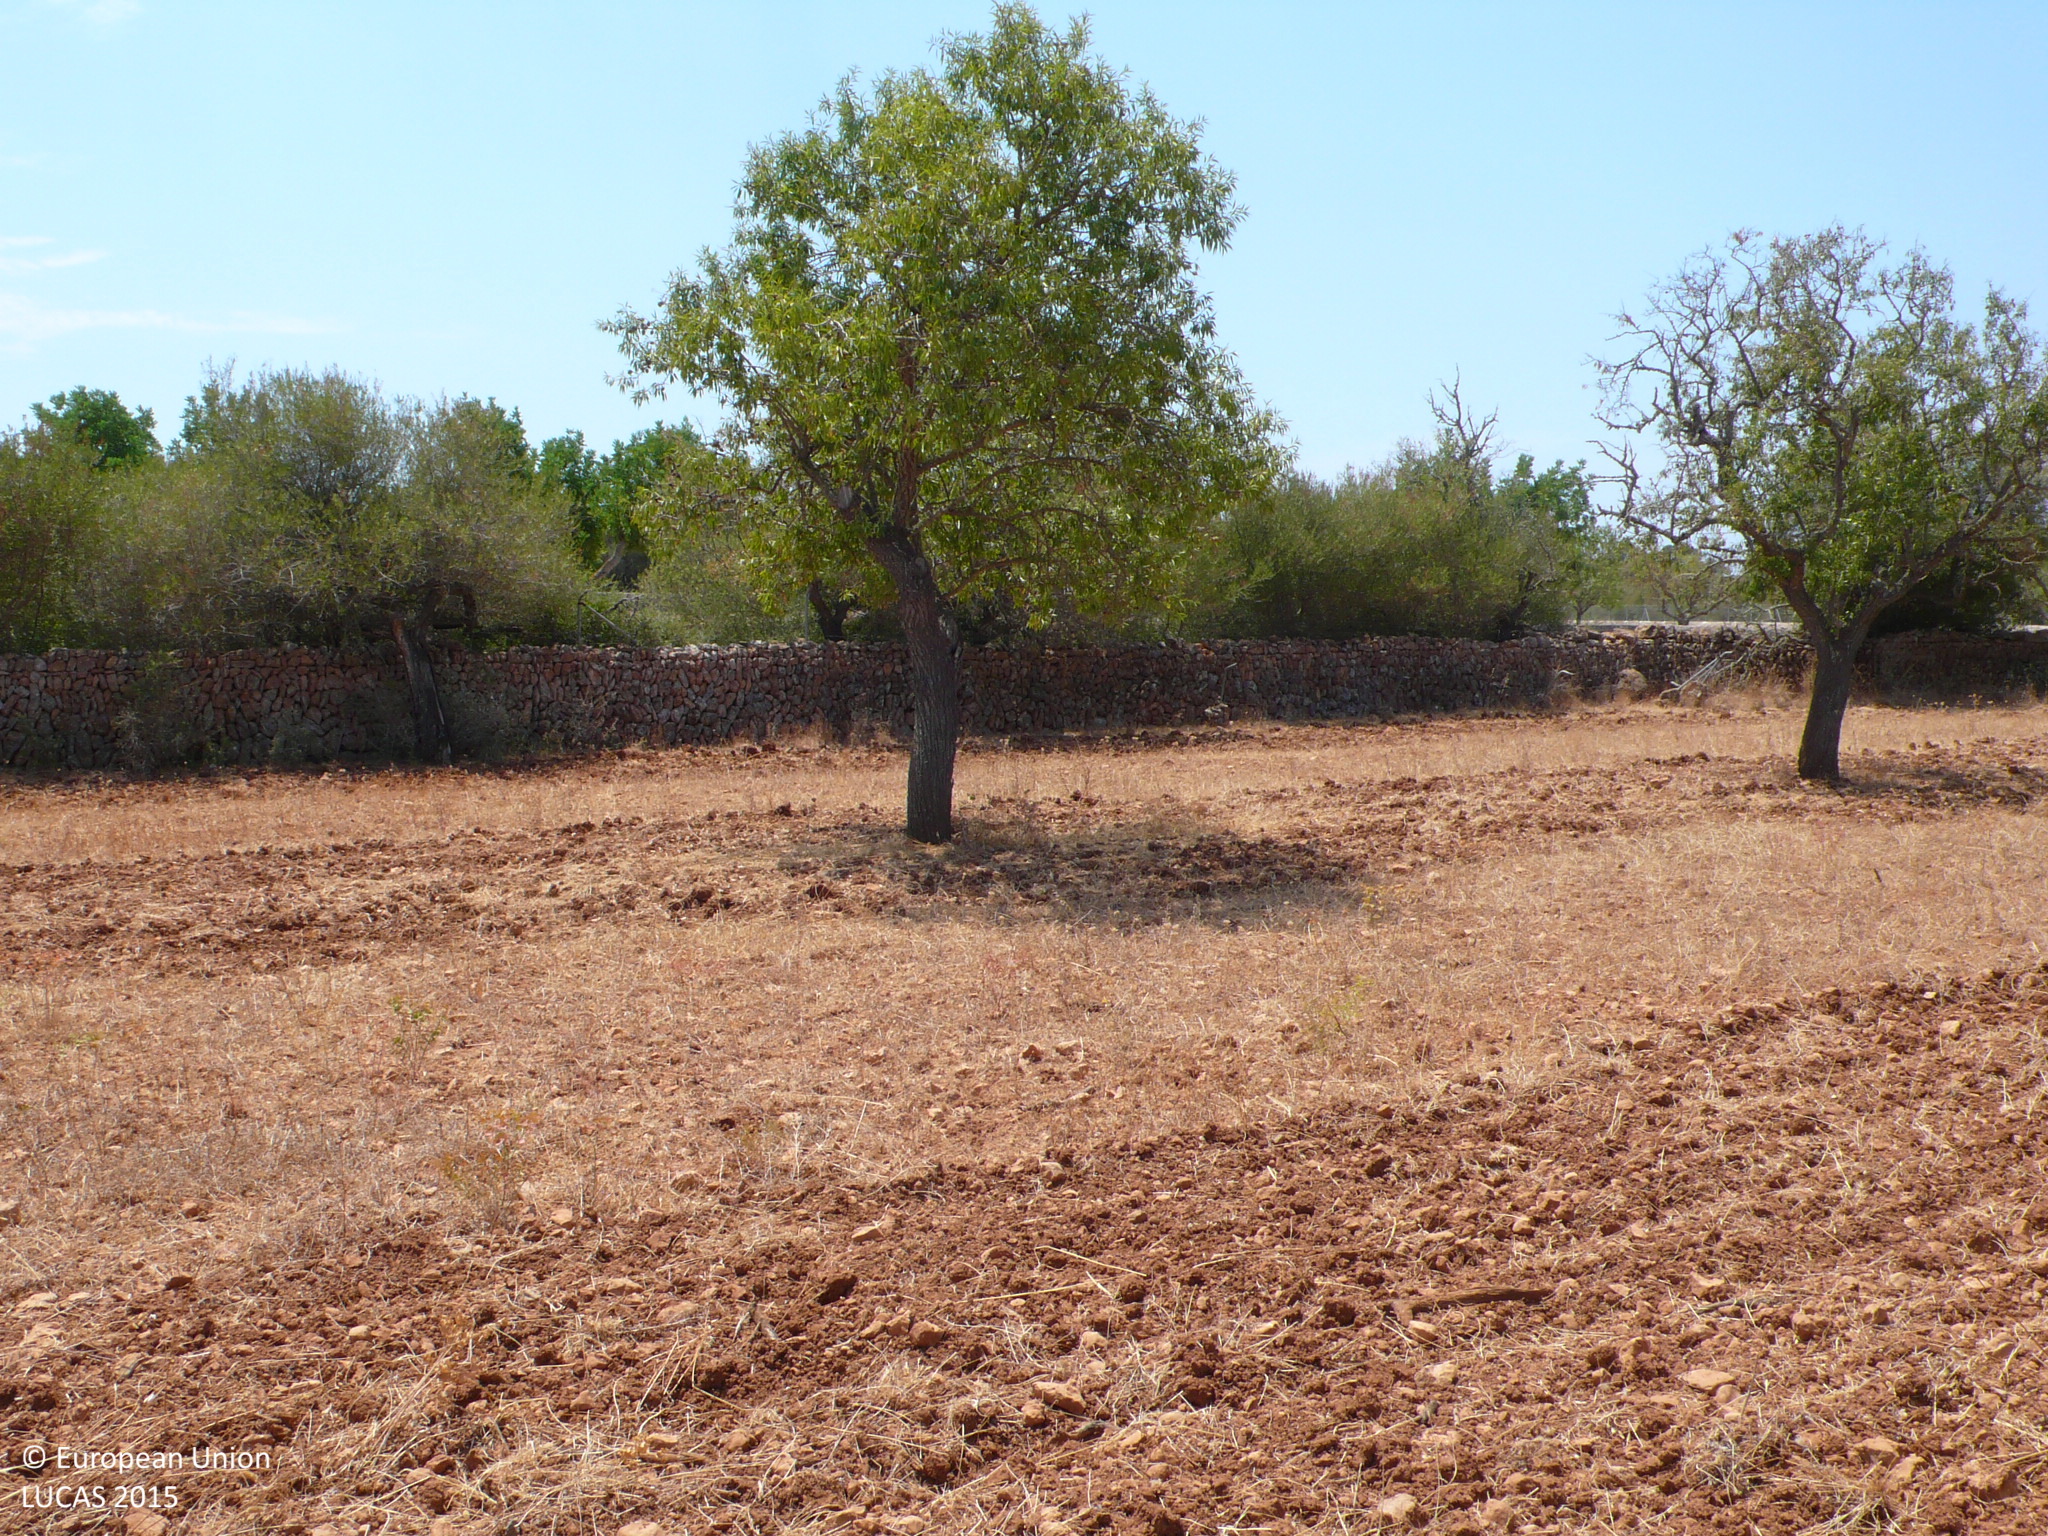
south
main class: Cropland
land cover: Nuts trees
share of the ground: 10 - 25 %
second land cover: Spontaneously vegetated surfaces
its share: 10 - 25 %
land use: Agriculture (excluding fallow land and kitchen gardens)
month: July
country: ES
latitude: 39.4044
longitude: 2.8199
